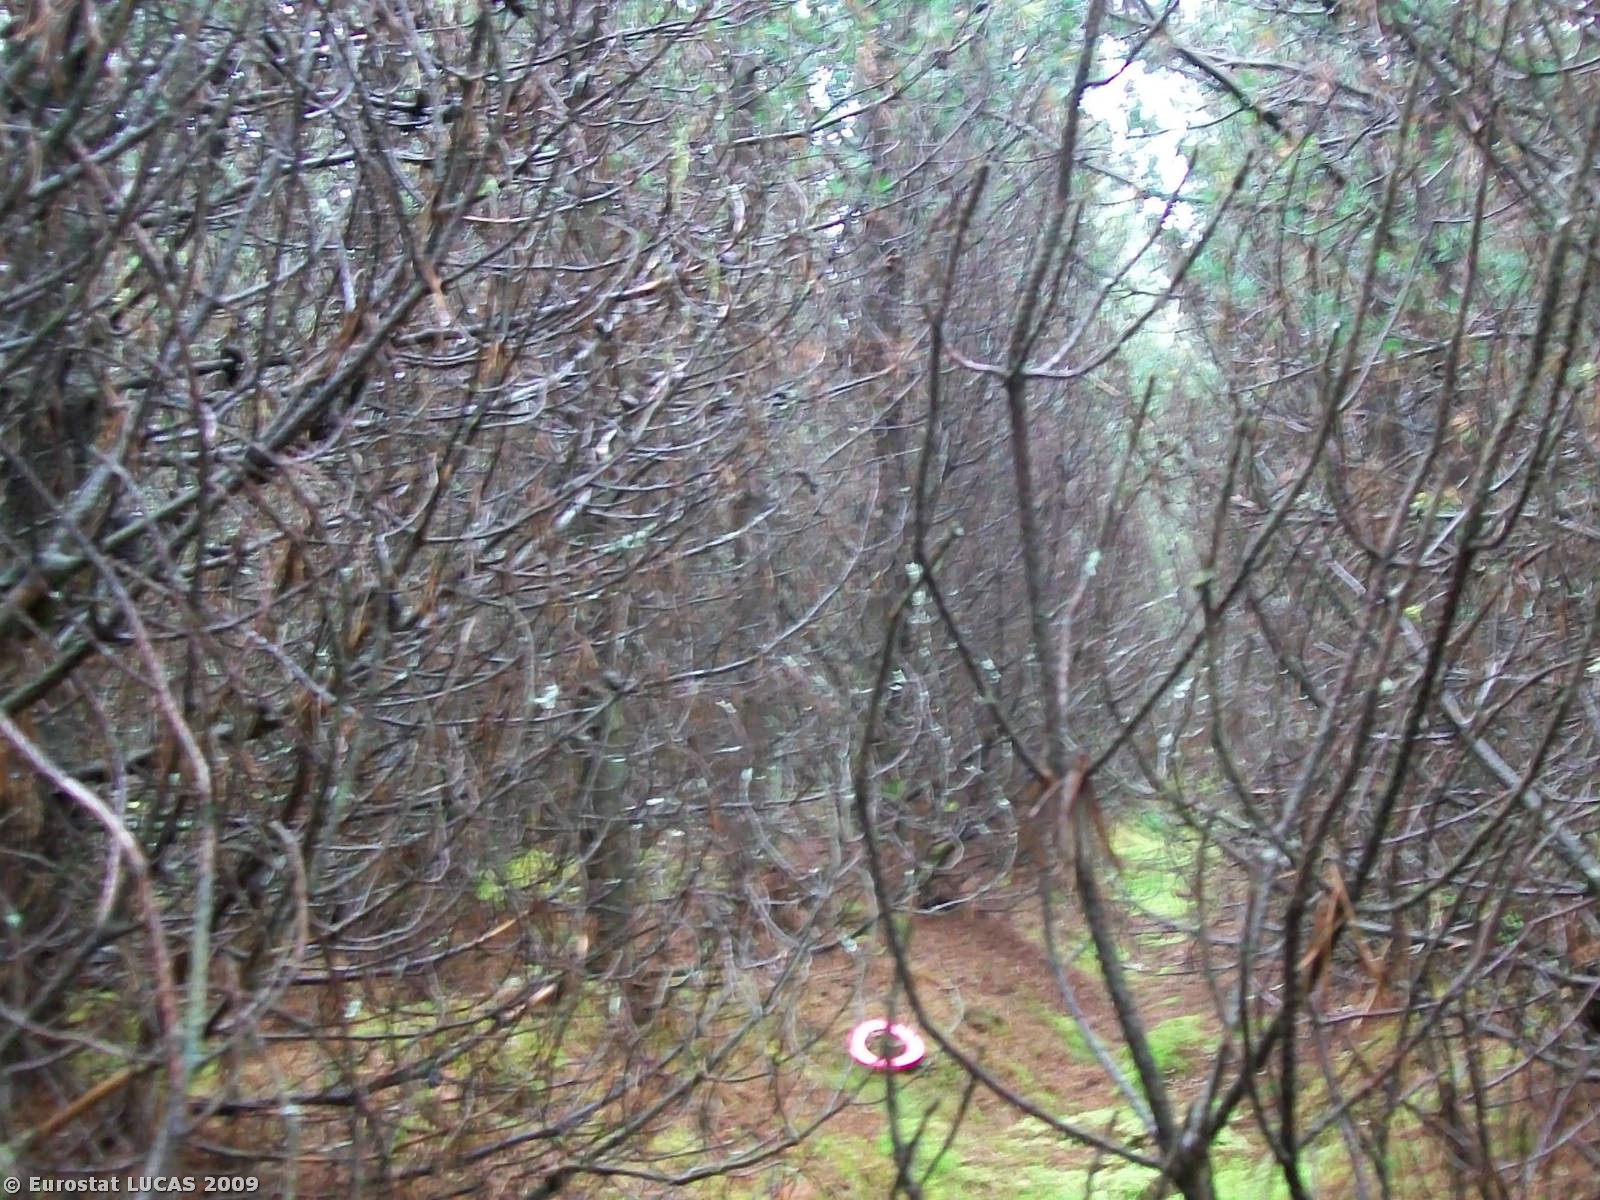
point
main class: Woodland
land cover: Coniferous woodland
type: plantations and self-sown exotic forest
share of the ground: > 75 %
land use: Forestry
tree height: > 5 m
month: August
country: GB
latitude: 58.6245
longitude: -3.1973
